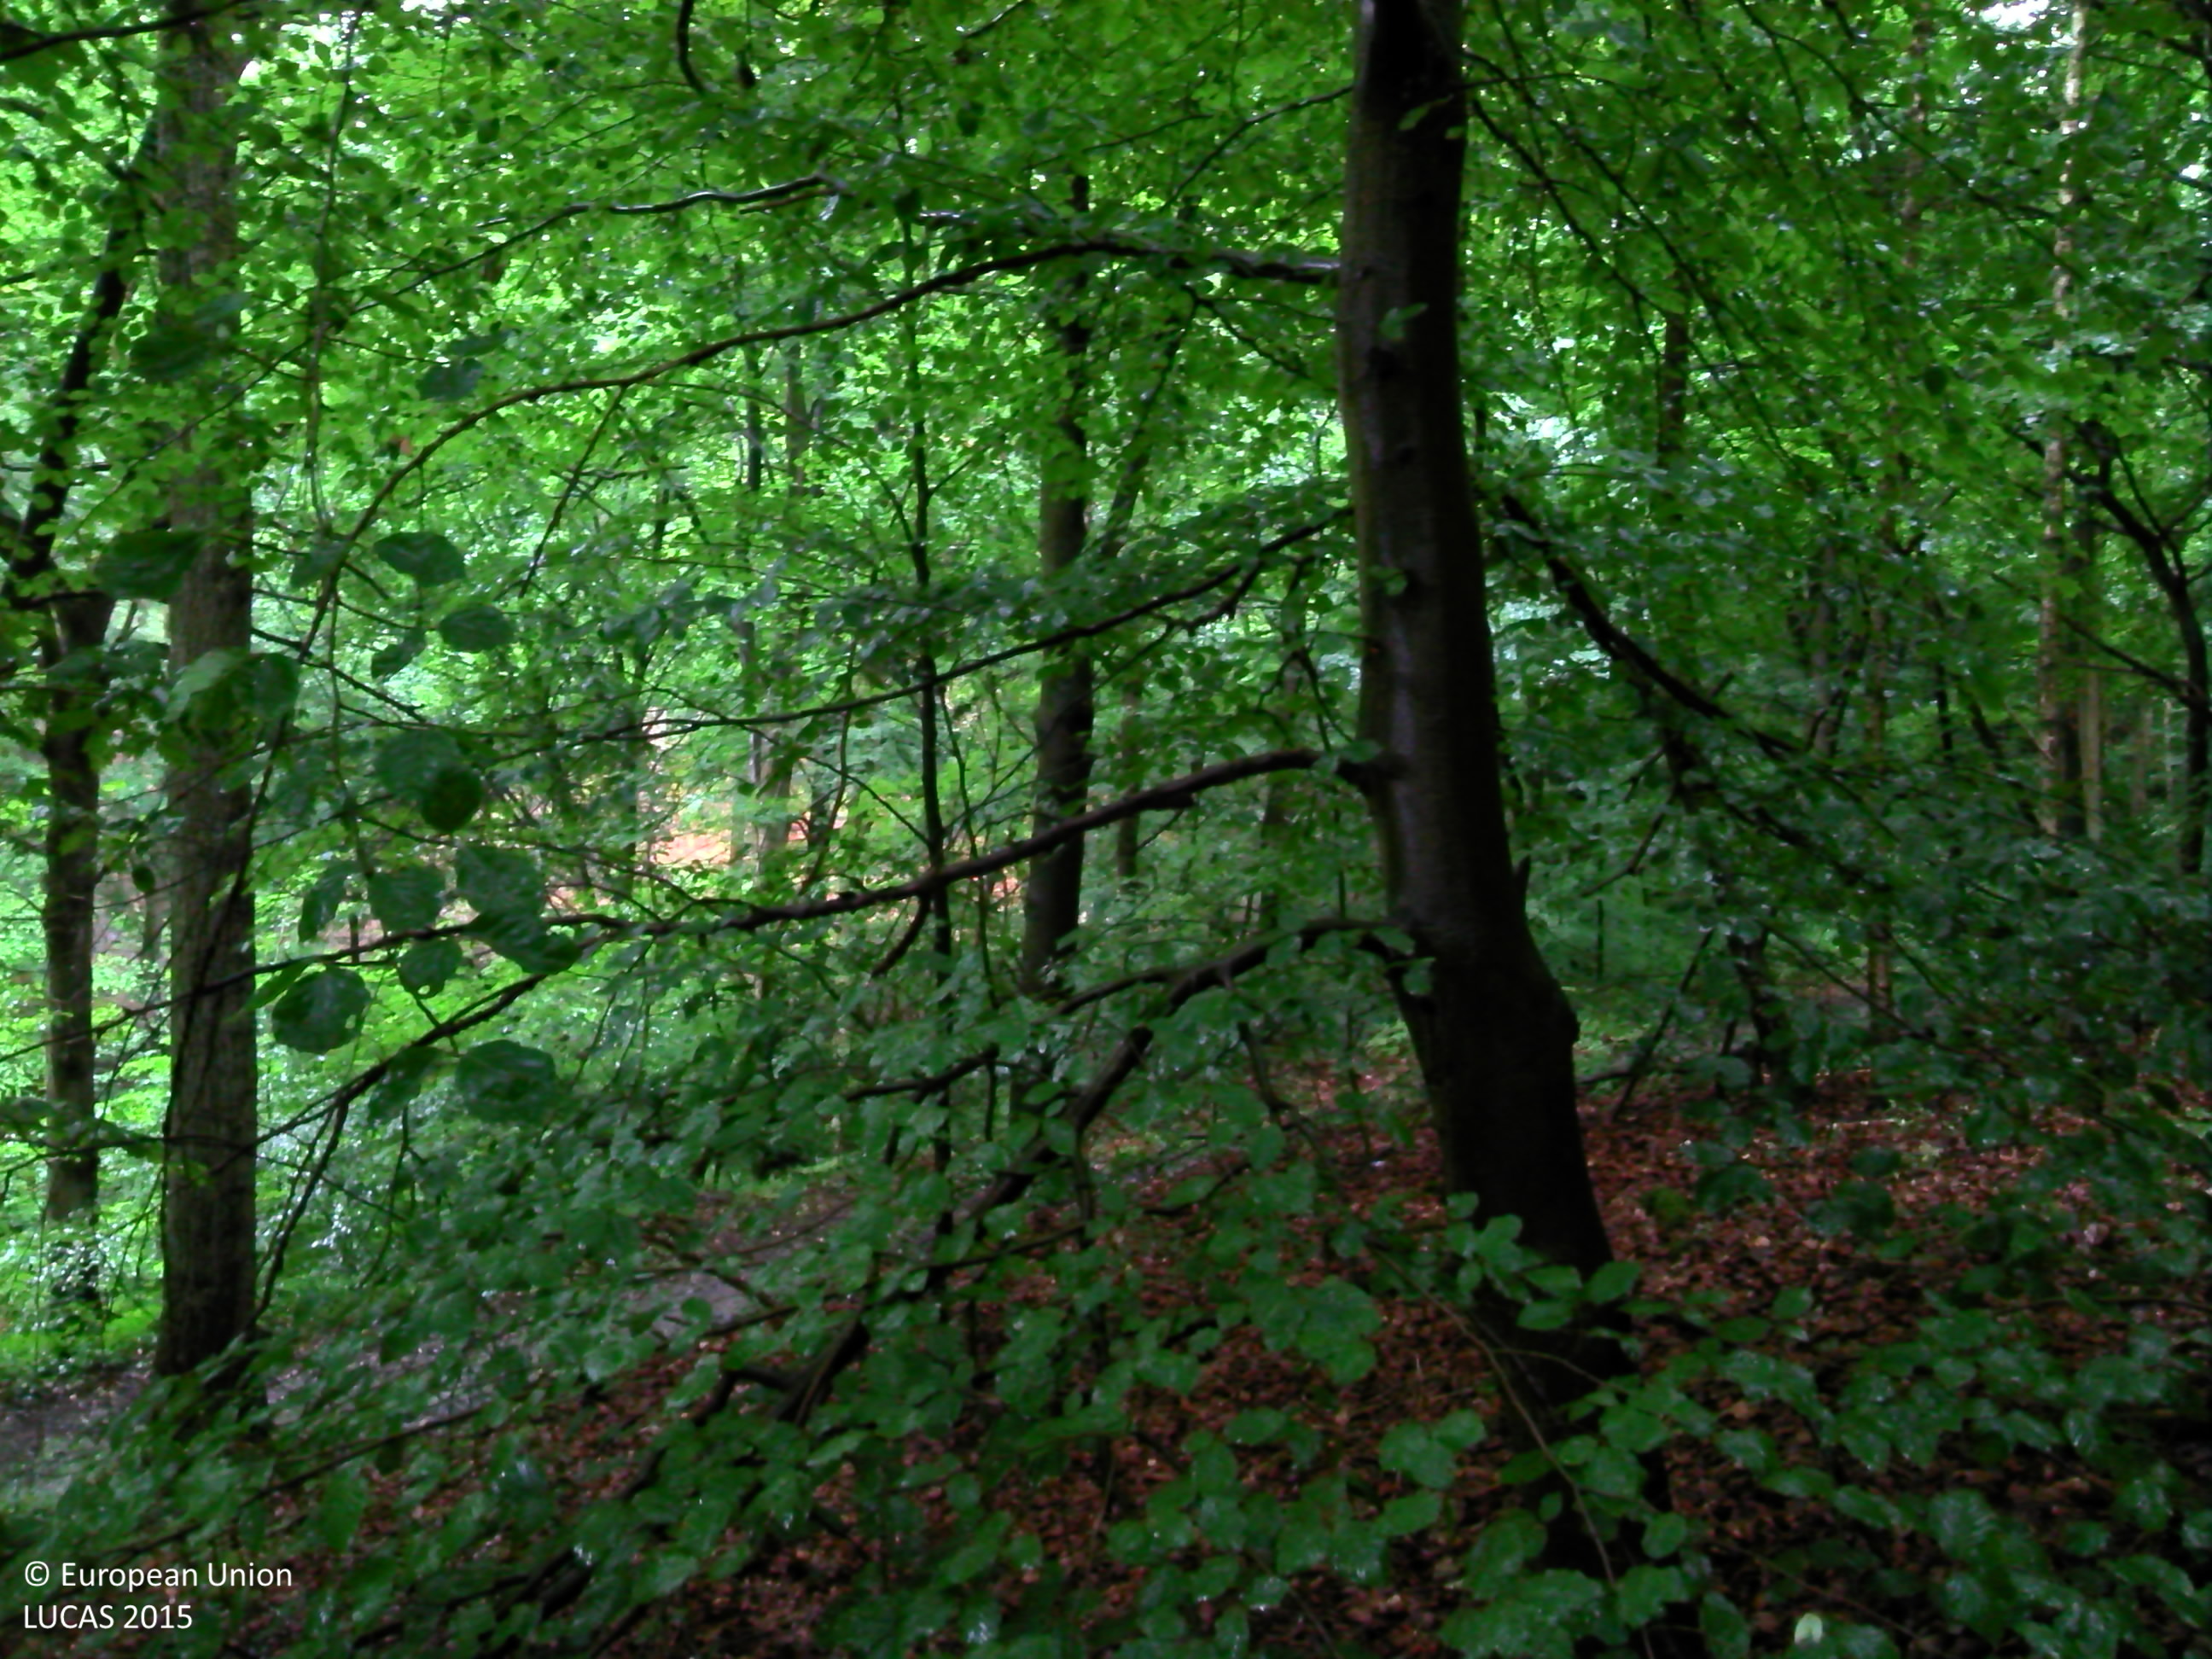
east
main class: Woodland
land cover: Broadleaved woodland
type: acidophilous oak and oak-birch forest
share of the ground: > 75 %
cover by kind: broadleaved forest trees 95 %, herbaceous plants 5 %
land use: Forestry
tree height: > 5 m
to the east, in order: Broadleaved woodland; Tracks; Broadleaved woodland; Rivers and streams; Broadleaved woodland; Tracks; Spruce dominated coniferous woodland; Broadleaved woodland
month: July
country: BE
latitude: 50.5197
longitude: 5.3011
